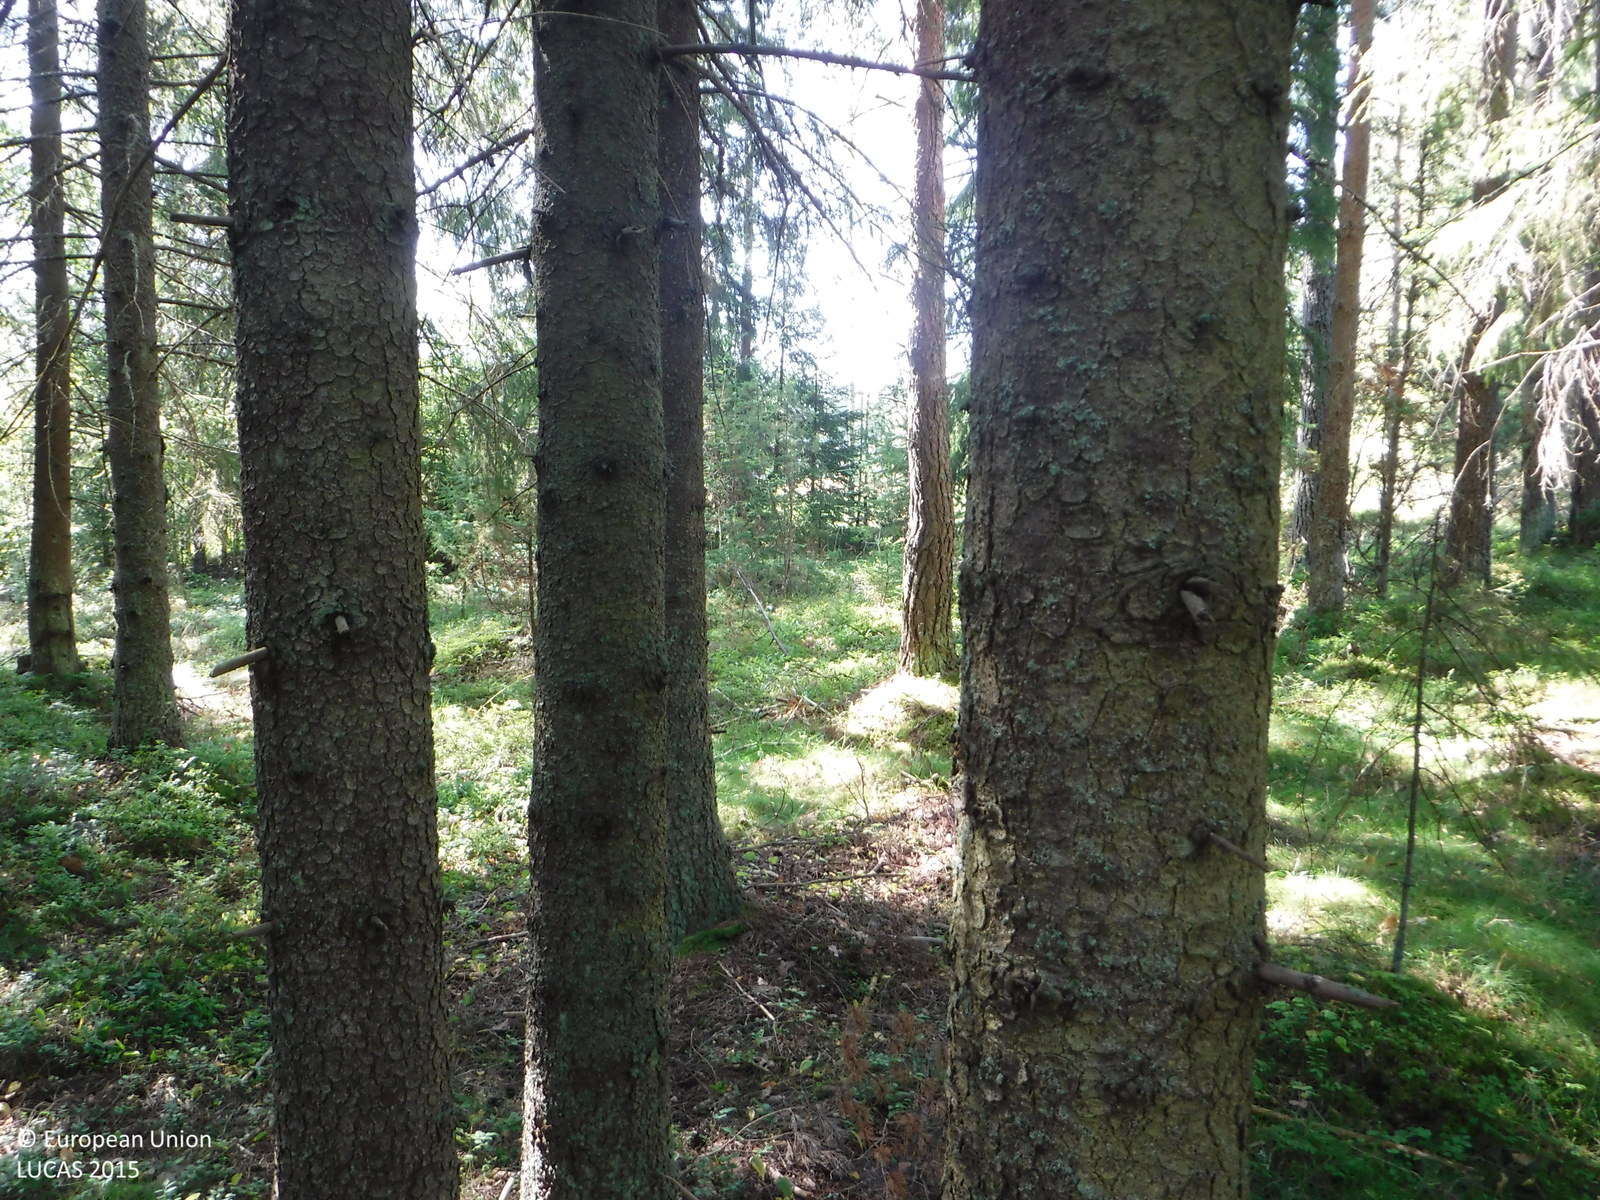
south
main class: Woodland
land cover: Spruce dominated coniferous woodland
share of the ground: > 75 %
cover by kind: coniferous forest trees 80 %, unconsolidated bare surface 15 %, herbaceous plants 5 %
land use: Forestry
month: August
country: FI
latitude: 61.0878
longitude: 22.0192
